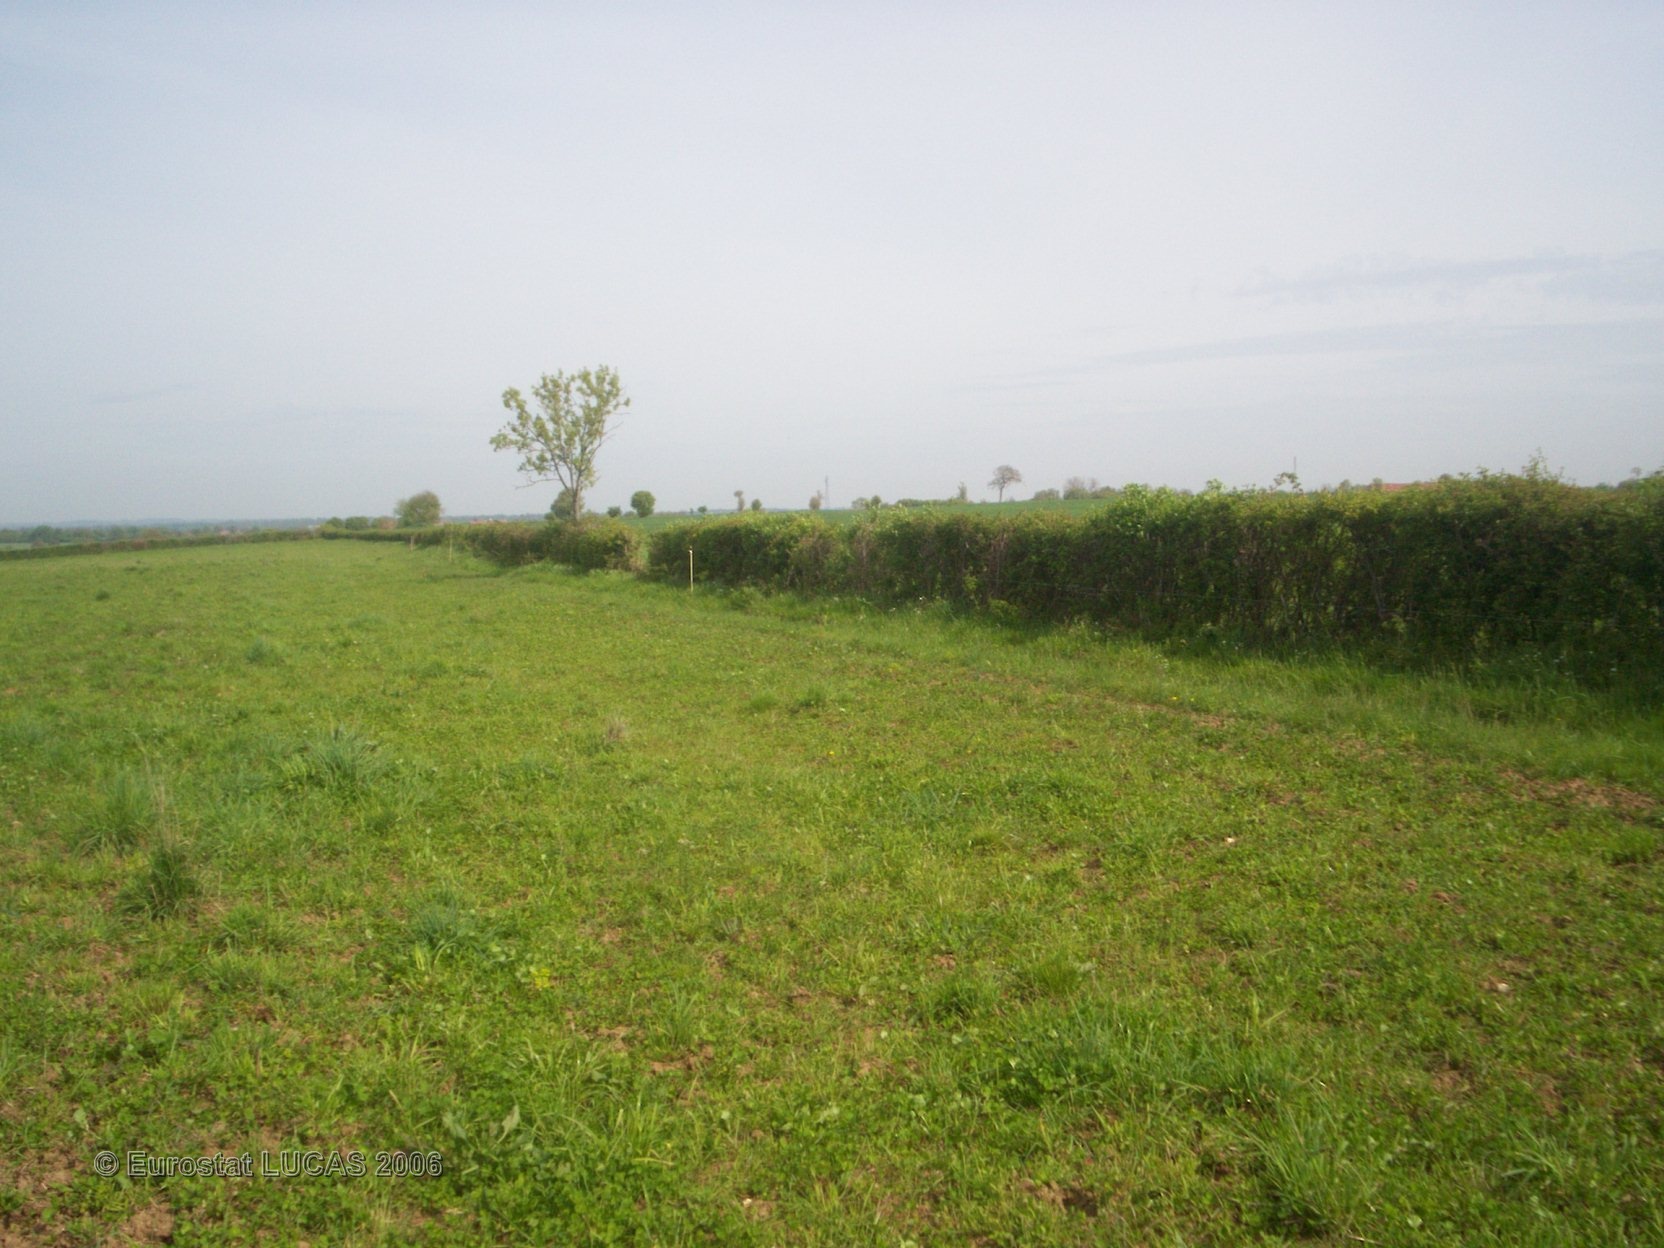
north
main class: Grassland
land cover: Grassland without tree/shrub cover
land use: Agriculture (excluding fallow land and kitchen gardens)
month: May
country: FR
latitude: 46.5472
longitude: 3.1507
